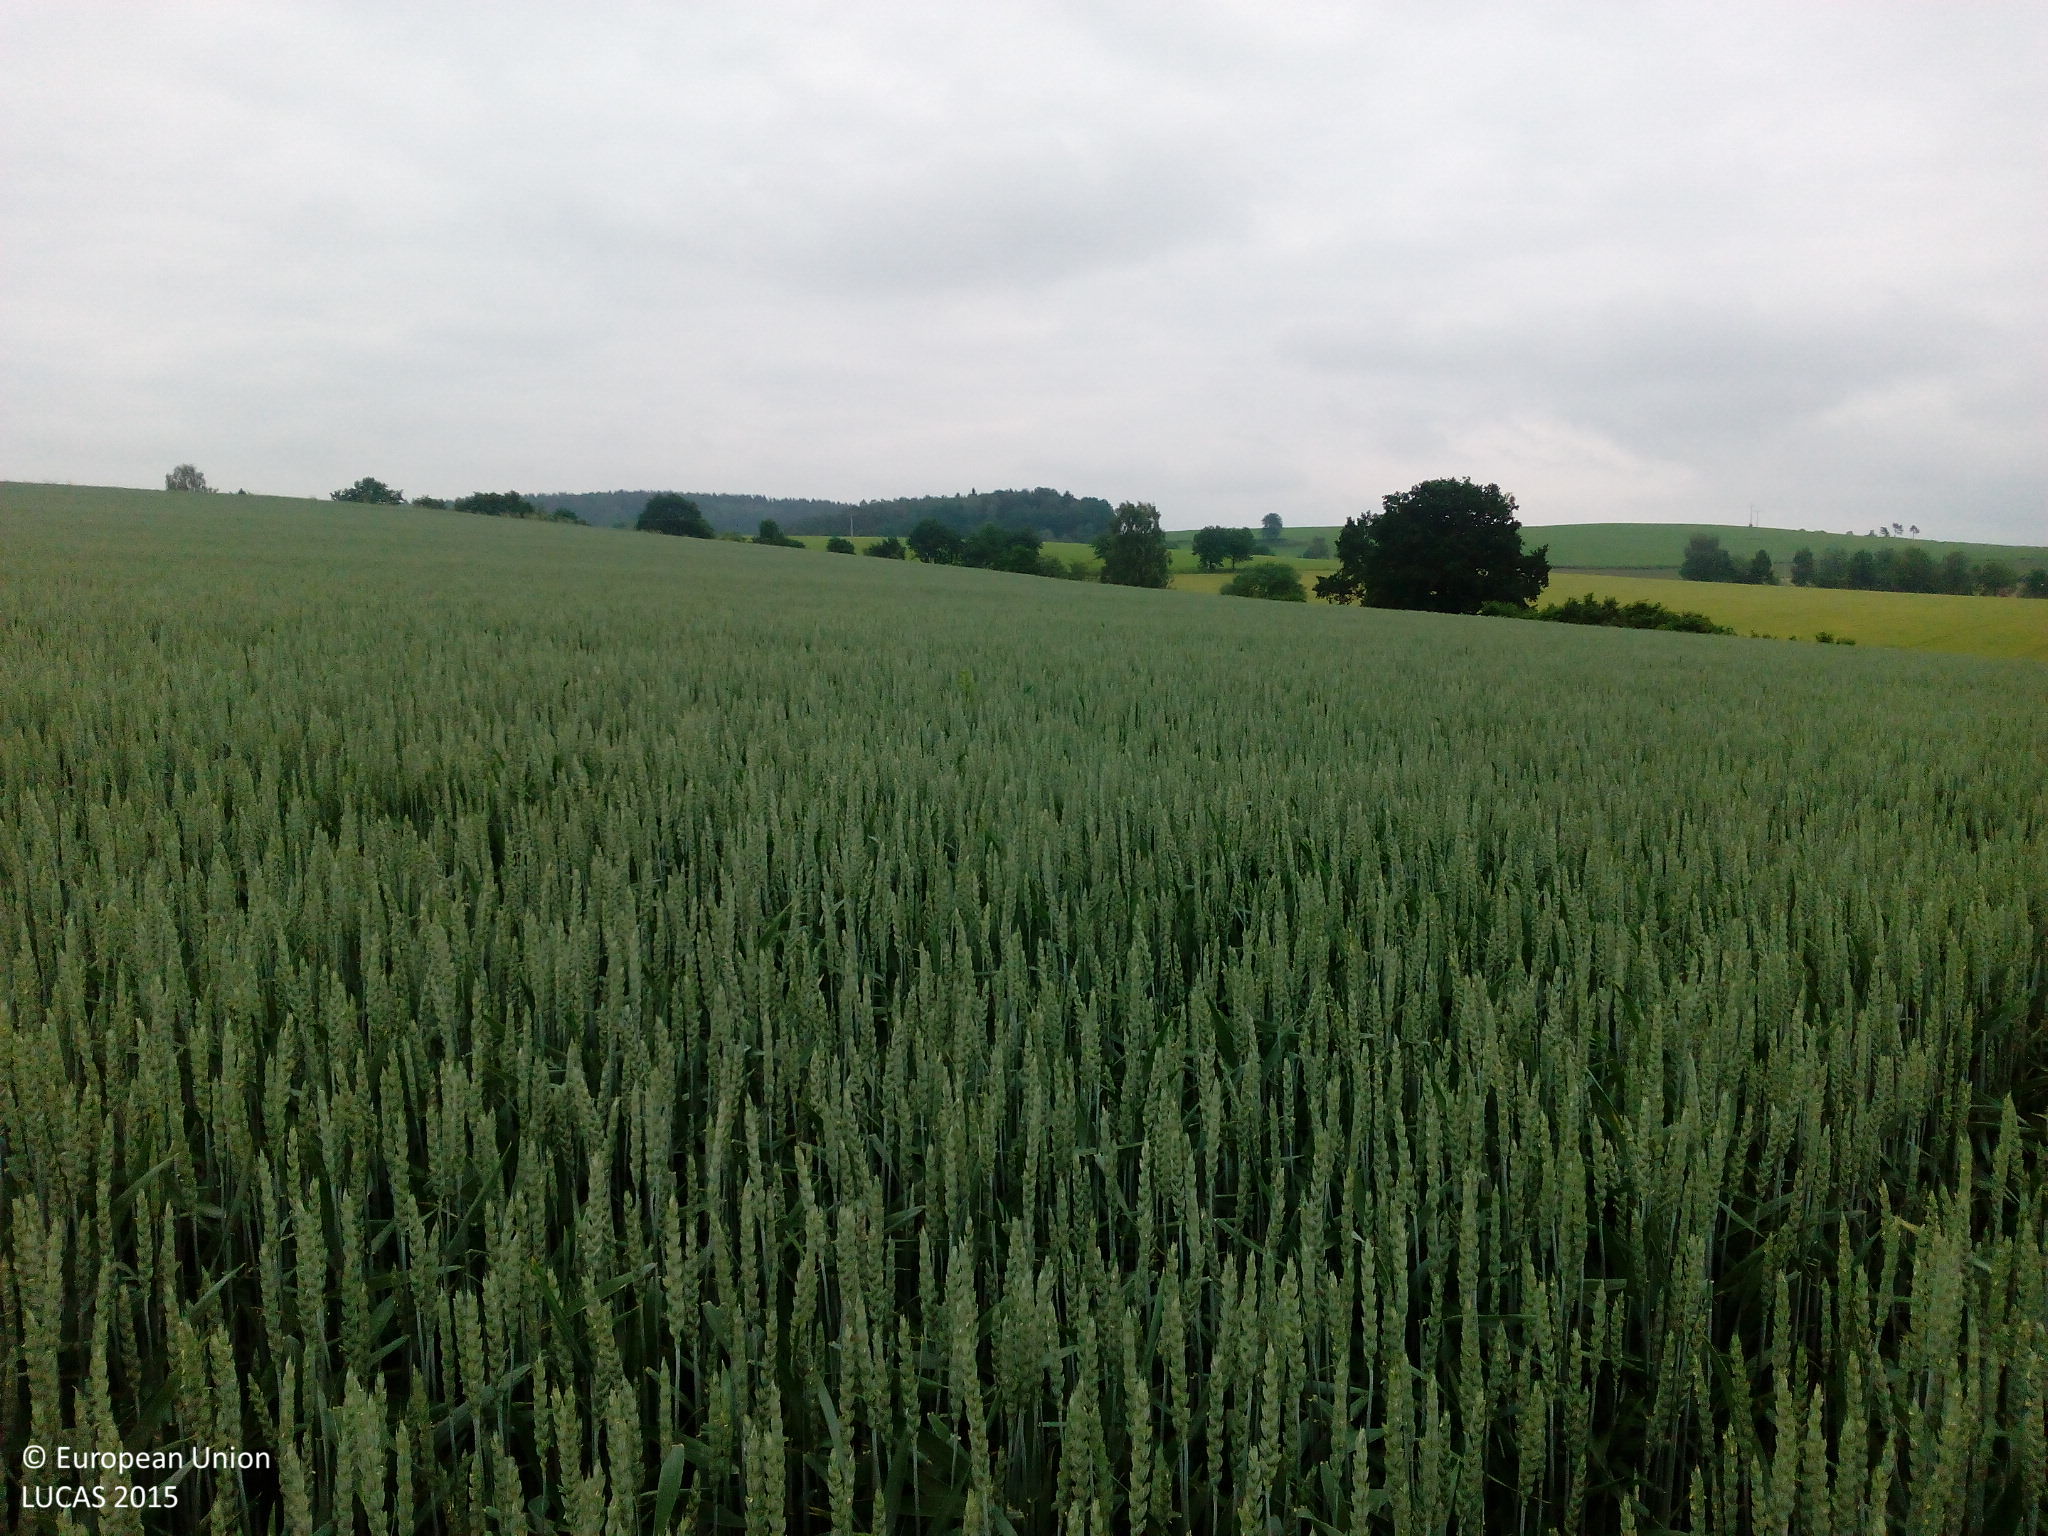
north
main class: Cropland
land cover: Common wheat
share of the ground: > 75 %
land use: Agriculture (excluding fallow land and kitchen gardens)
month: June
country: DE
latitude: 49.4582
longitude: 12.3587
